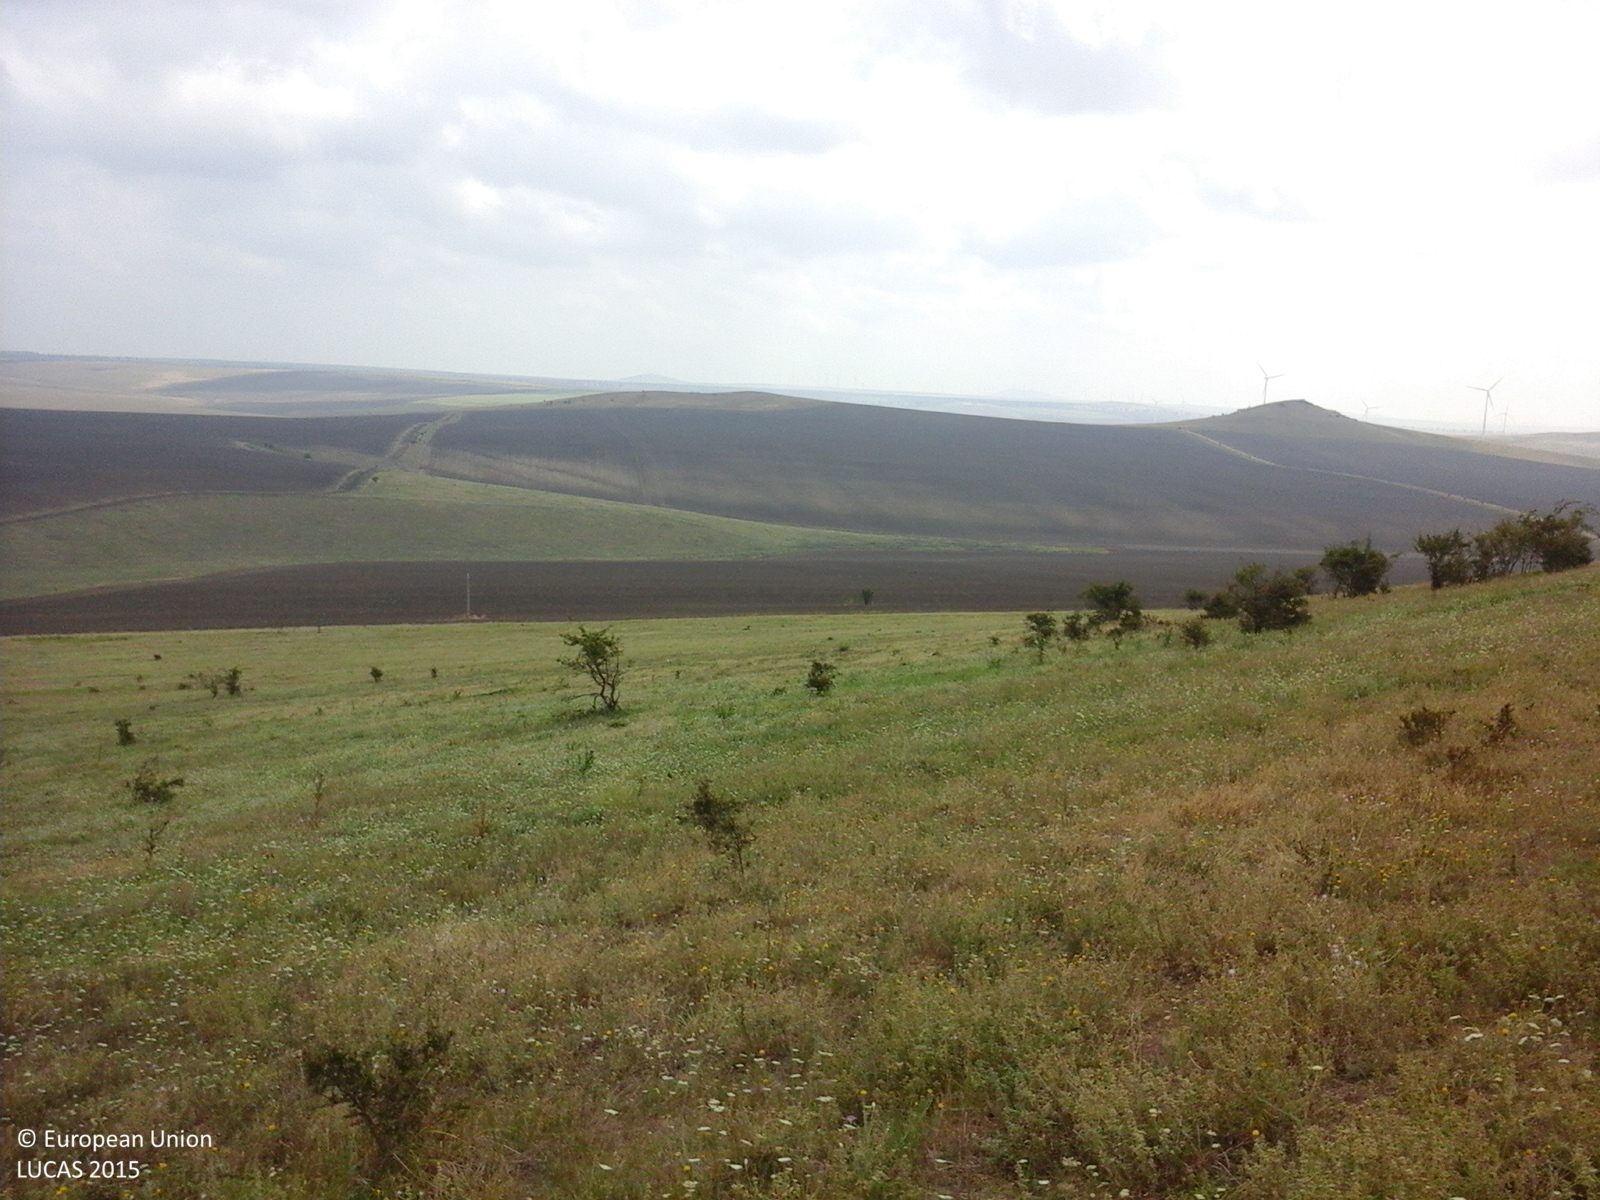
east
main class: Grassland
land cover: Grassland with sparse tree/shrub cover
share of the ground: > 75 %
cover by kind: herbaceous plants 85 %, shrubs 10 %, broadleaved forest trees 5 %
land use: Agriculture (excluding fallow land and kitchen gardens)
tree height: < 5 m
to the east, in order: Grassland with sparse tree/shrub cover; Grassland without tree/shrub cover
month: July
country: RO
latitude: 45.0757
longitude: 28.7736
